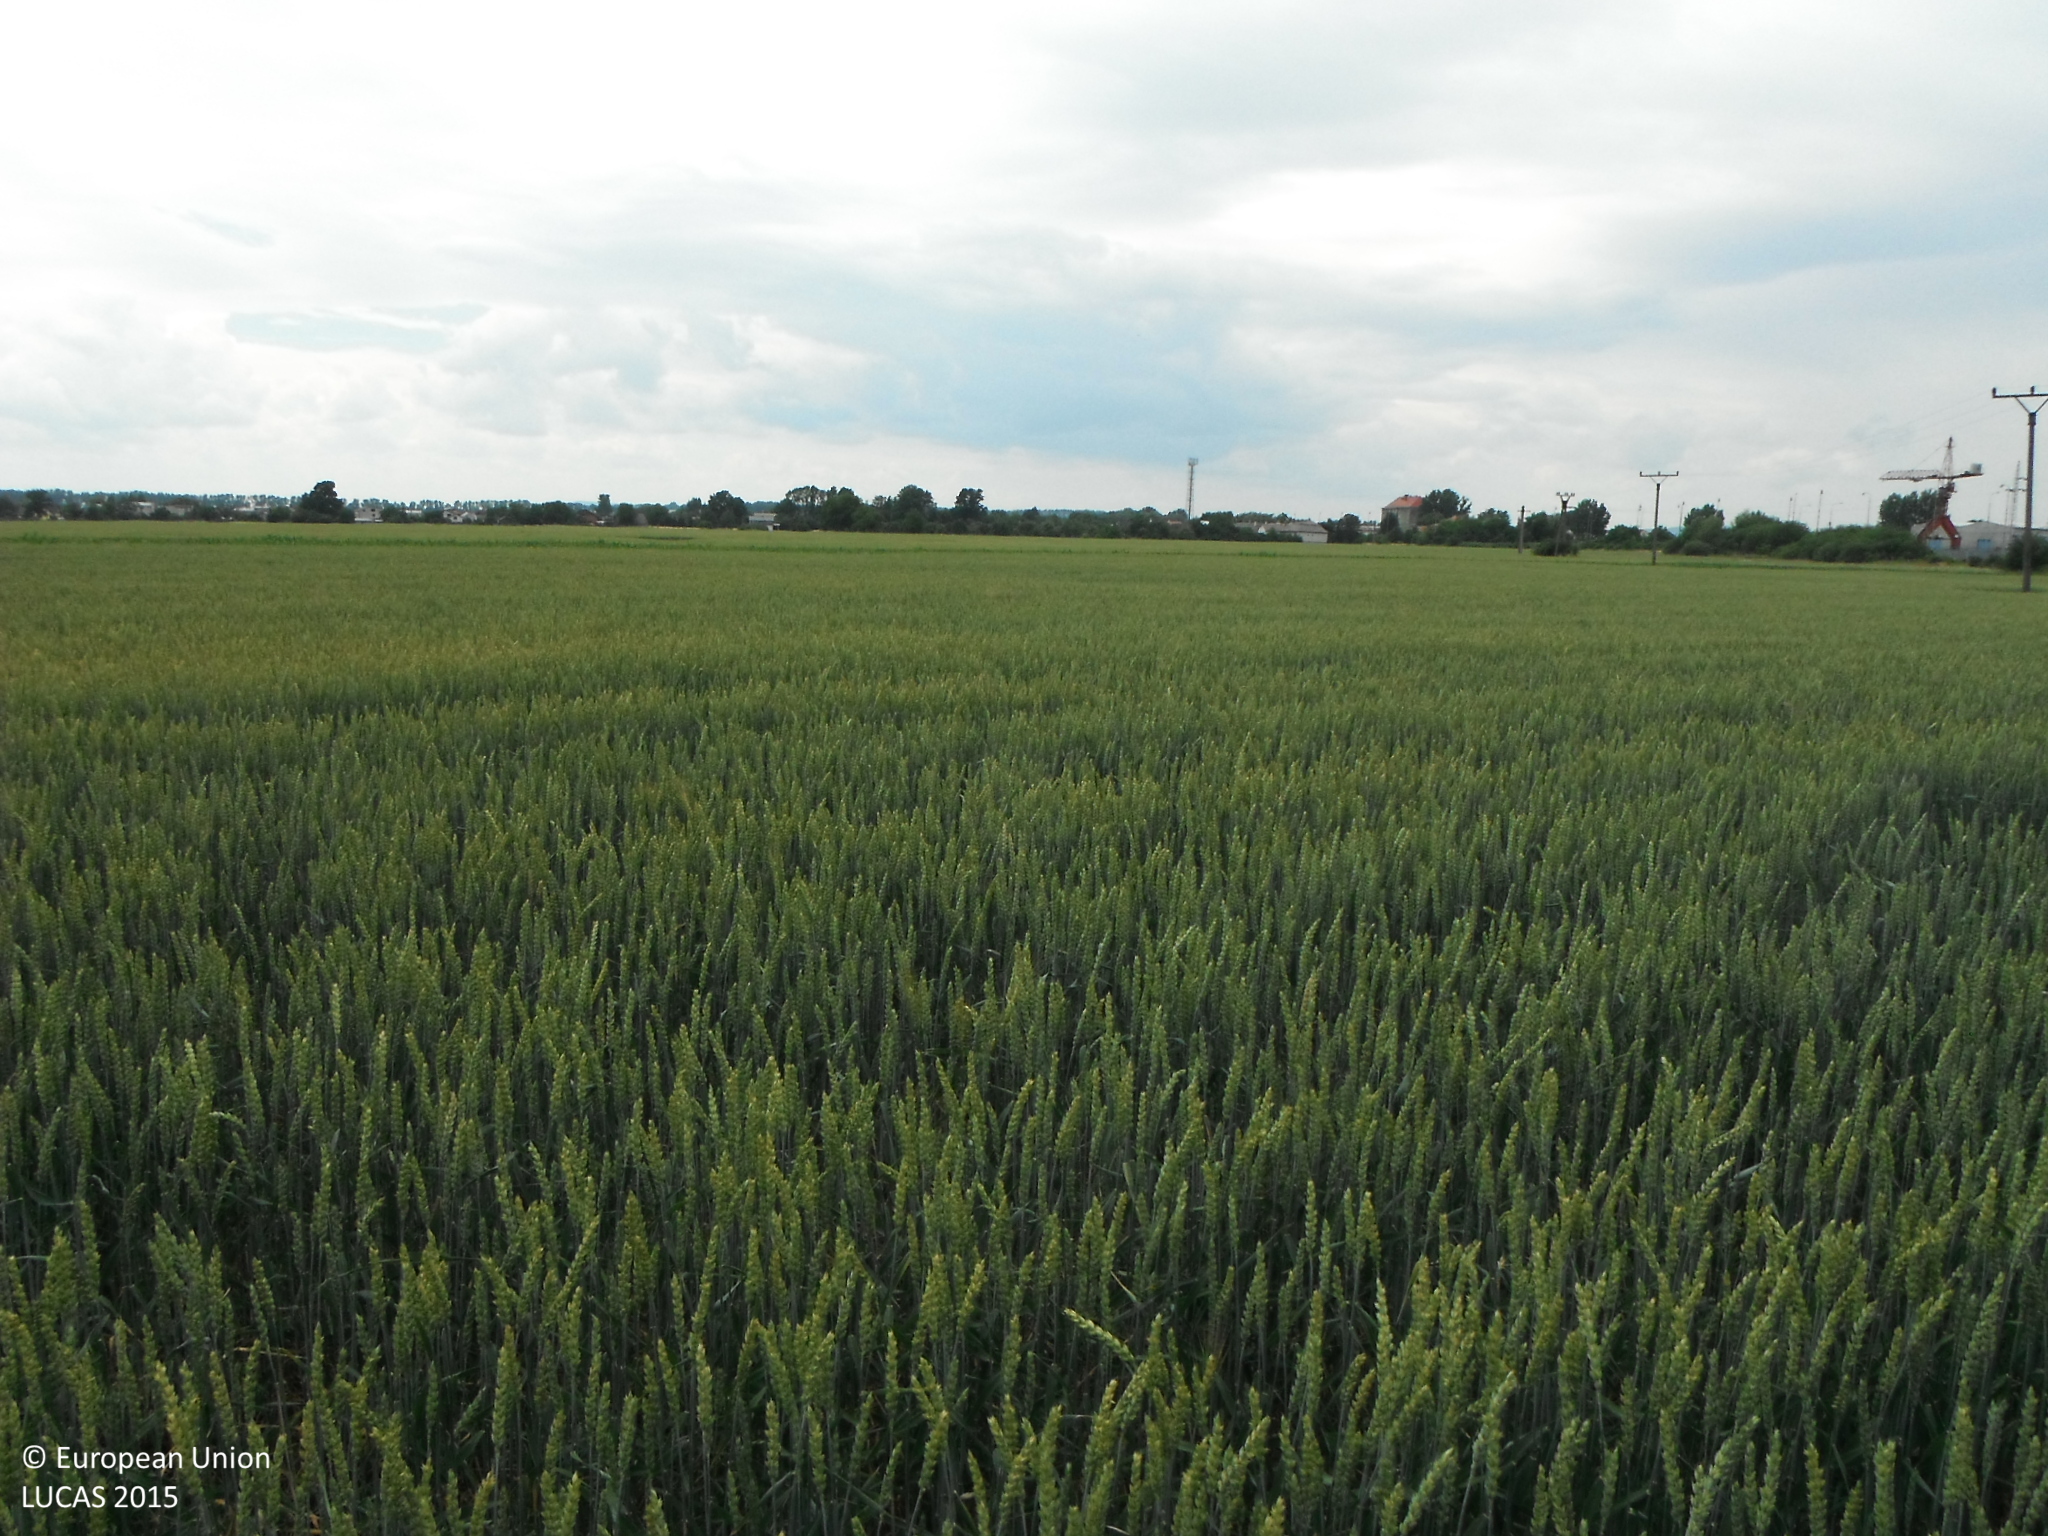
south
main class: Cropland
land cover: Common wheat
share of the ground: > 75 %
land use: Agriculture (excluding fallow land and kitchen gardens)
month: June
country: SK
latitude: 48.7103
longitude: 21.6695
